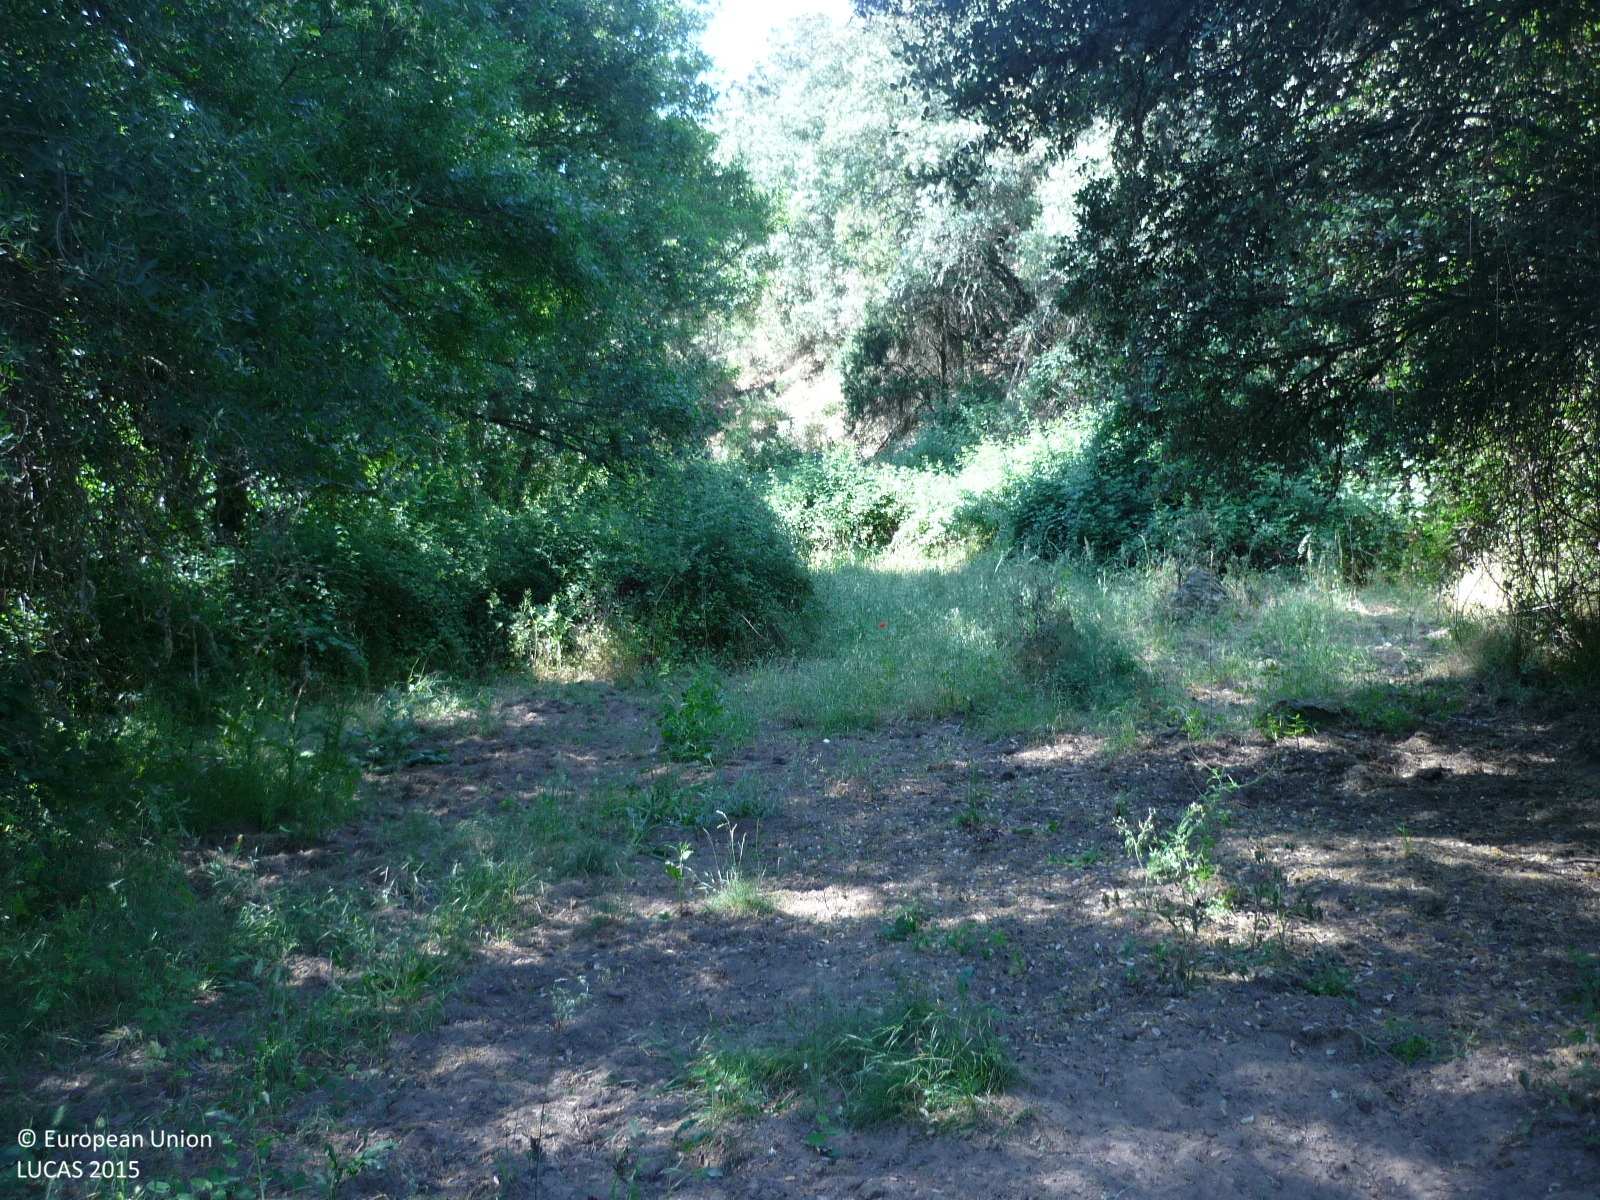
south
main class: Woodland
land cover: Broadleaved woodland
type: mesophytic deciduous forest
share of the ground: > 75 %
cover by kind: broadleaved forest trees 80 %, shrubs 10 %, herbaceous plants 10 %
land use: Semi-natural and natural areas not in use
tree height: < 5 m
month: June
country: ES
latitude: 40.7229
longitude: -3.6197
